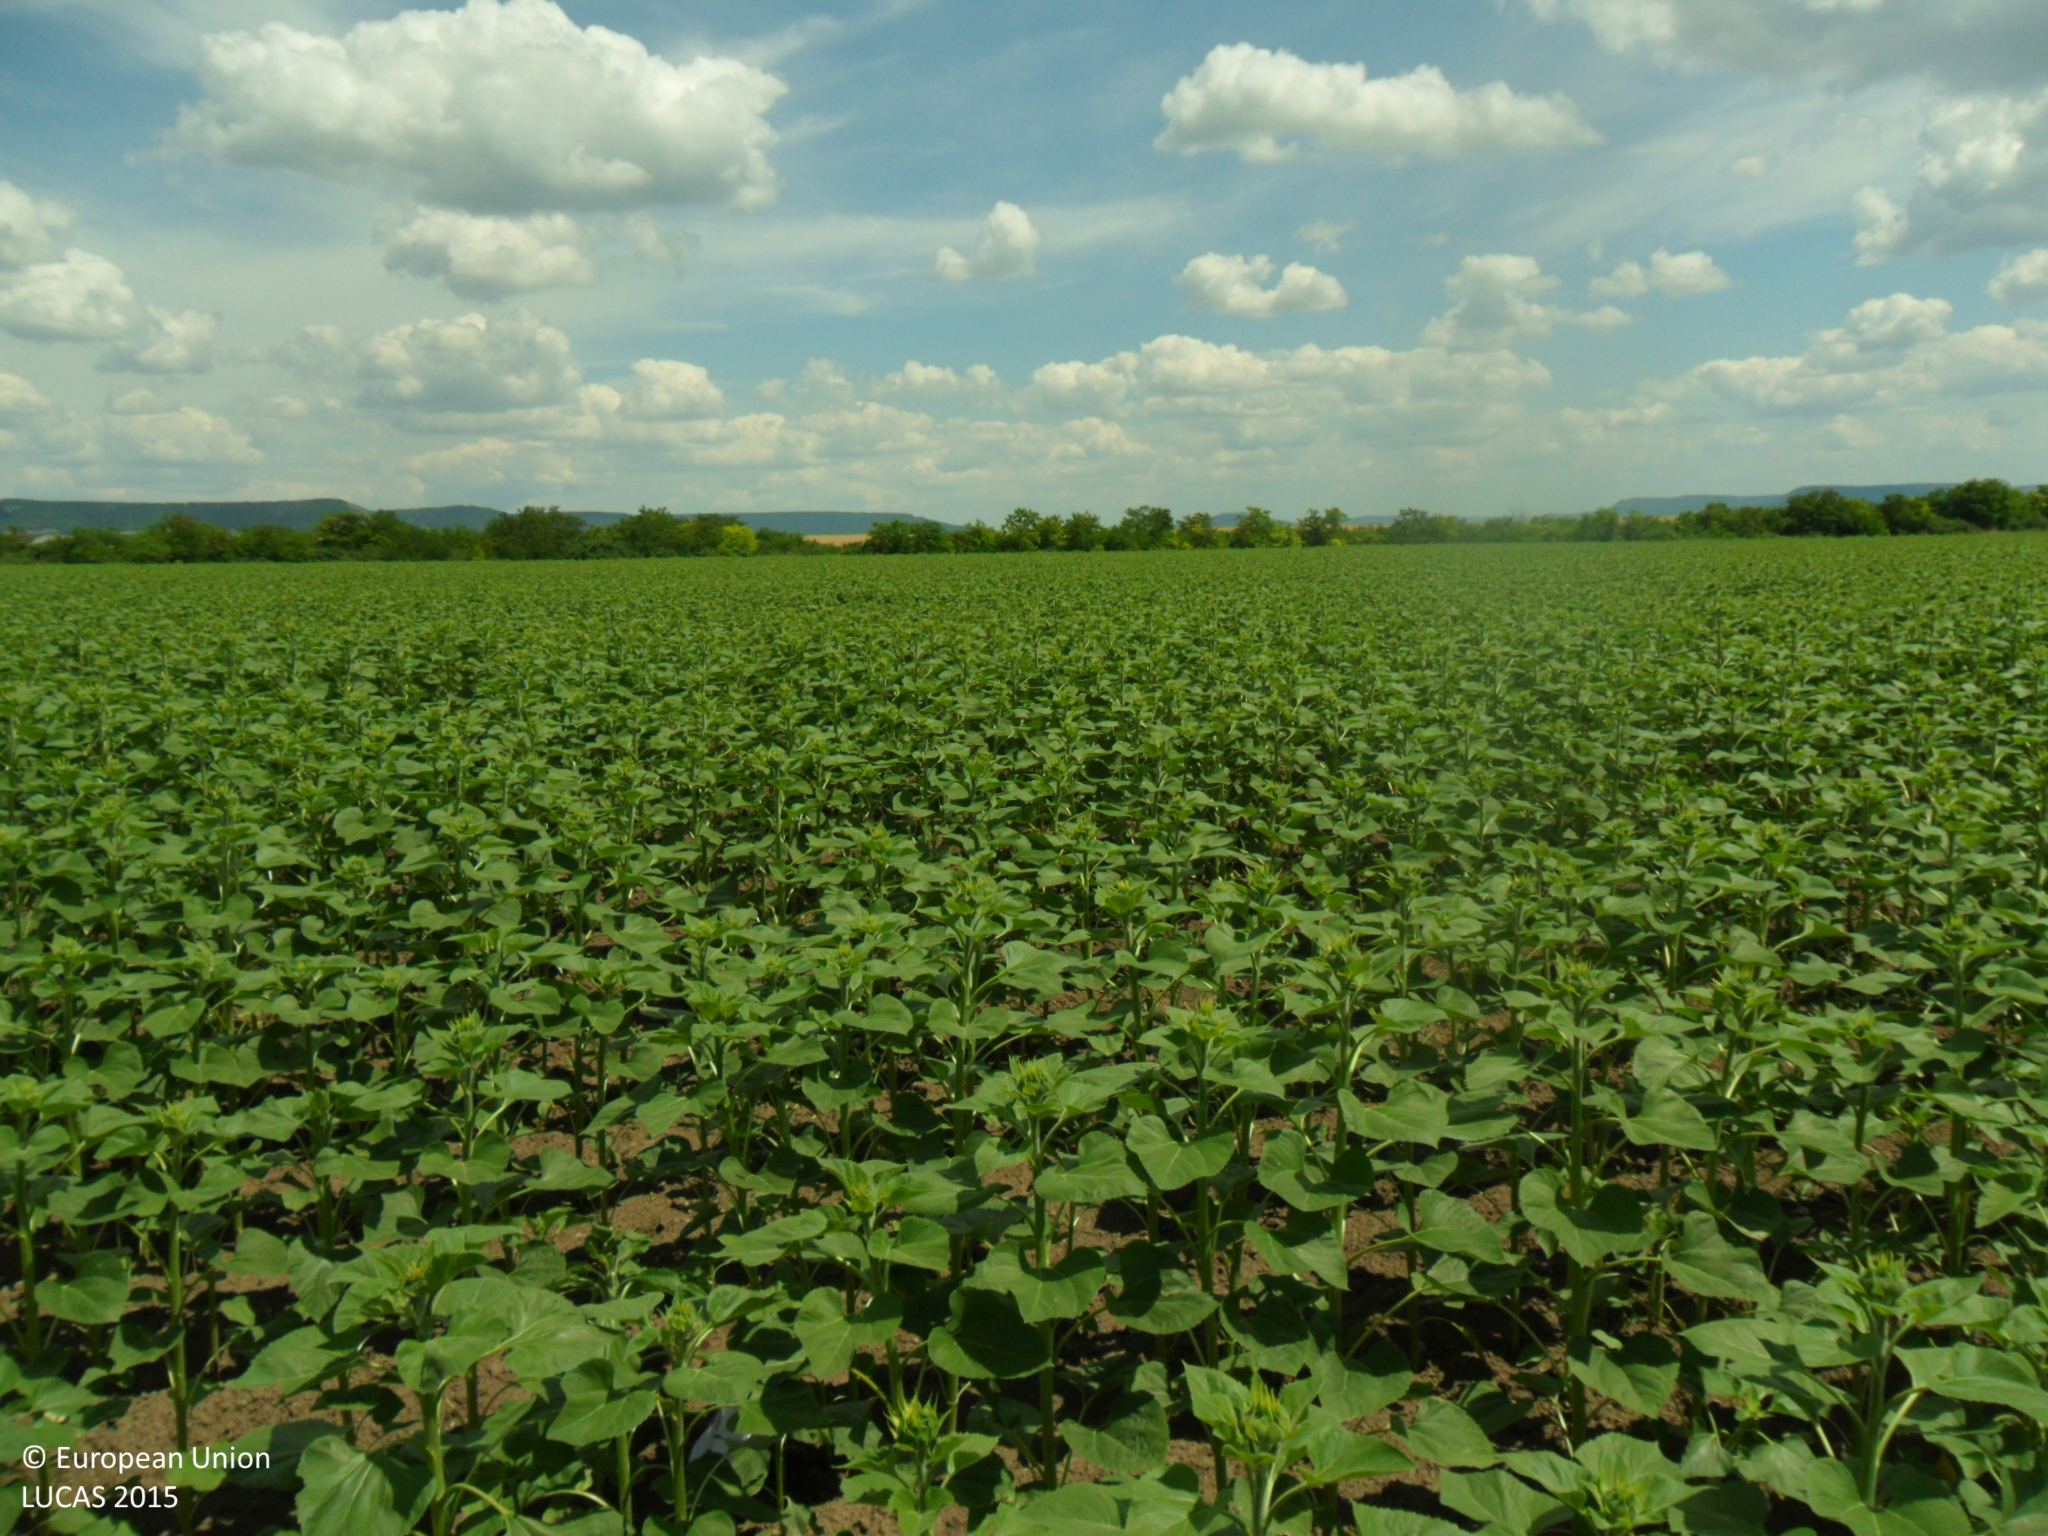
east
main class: Cropland
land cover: Sunflower
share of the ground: > 75 %
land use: Agriculture (excluding fallow land and kitchen gardens)
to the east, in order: Sunflower; Grass margins; Broadleaved woodland; Tracks; Common wheat
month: June
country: BG
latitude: 43.3894
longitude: 27.1436
